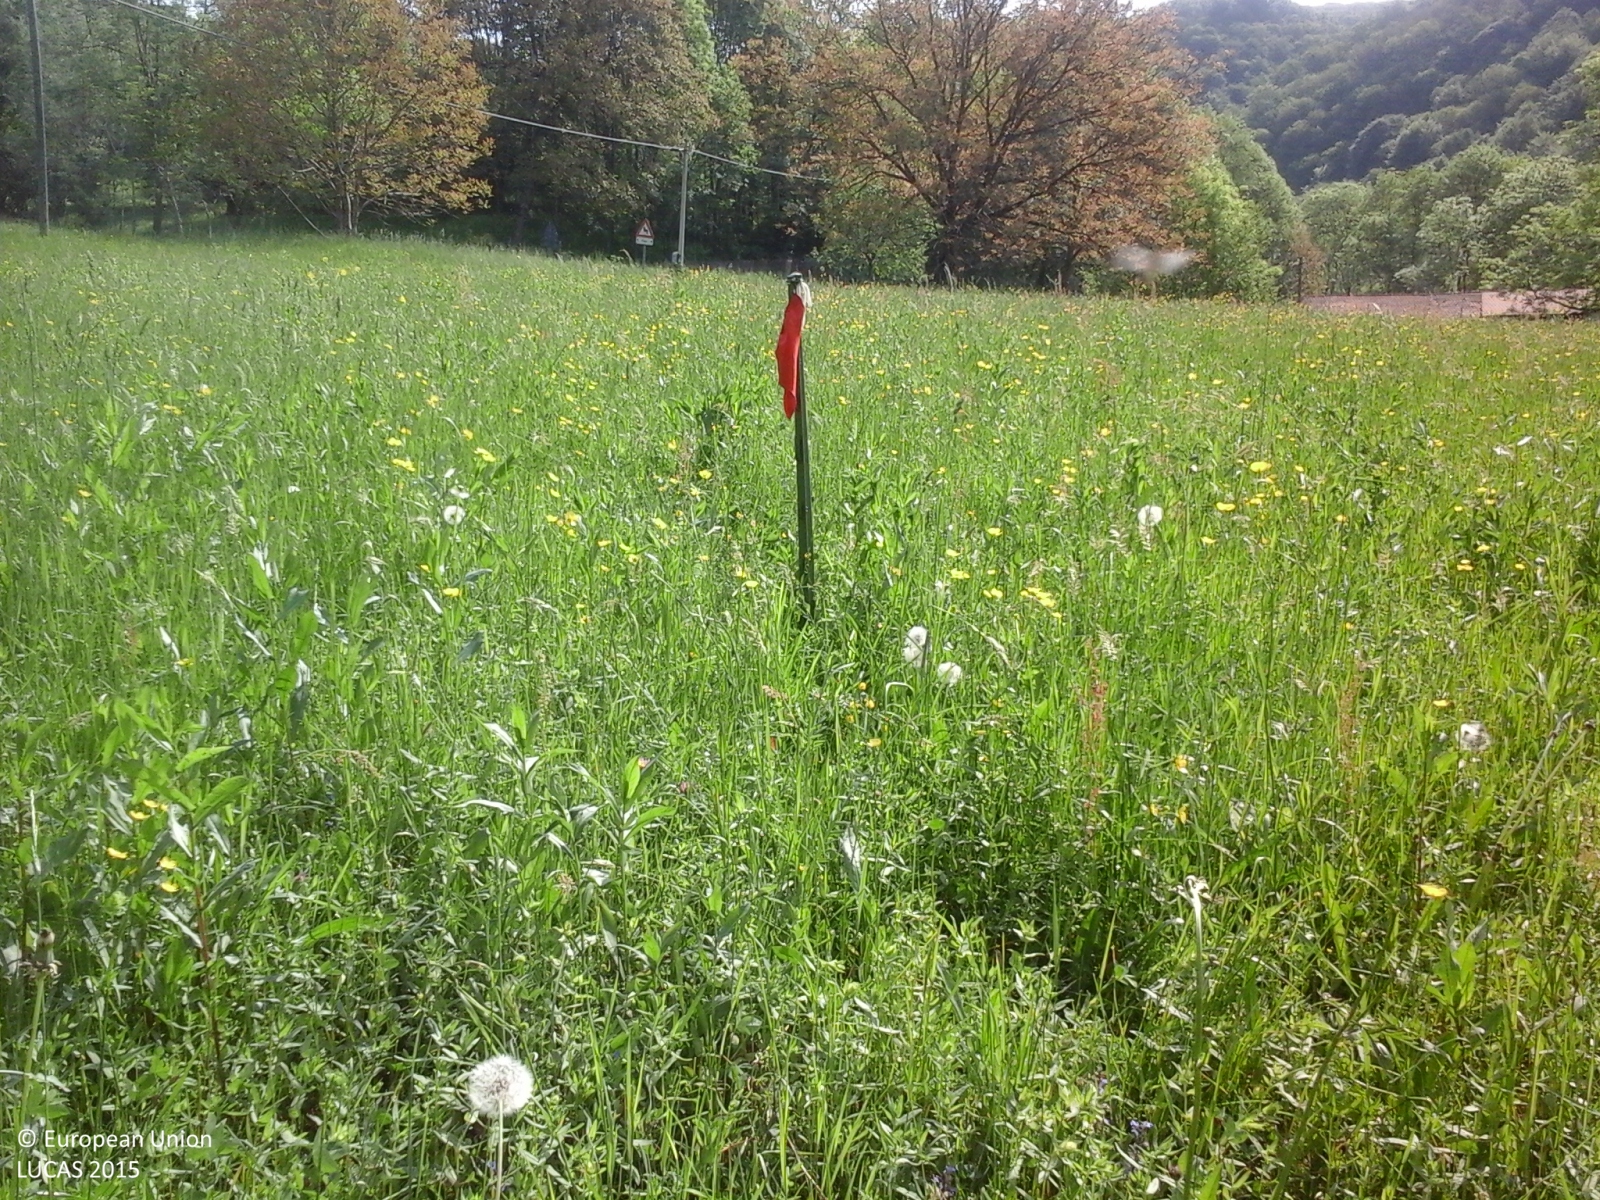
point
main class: Grassland
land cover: Grassland with sparse tree/shrub cover
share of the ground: > 75 %
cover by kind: herbaceous plants 95 %, broadleaved forest trees 5 %
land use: Agriculture (excluding fallow land and kitchen gardens)
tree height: > 5 m
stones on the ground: < 10 %
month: May
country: IT
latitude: 45.8177
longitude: 8.4707
